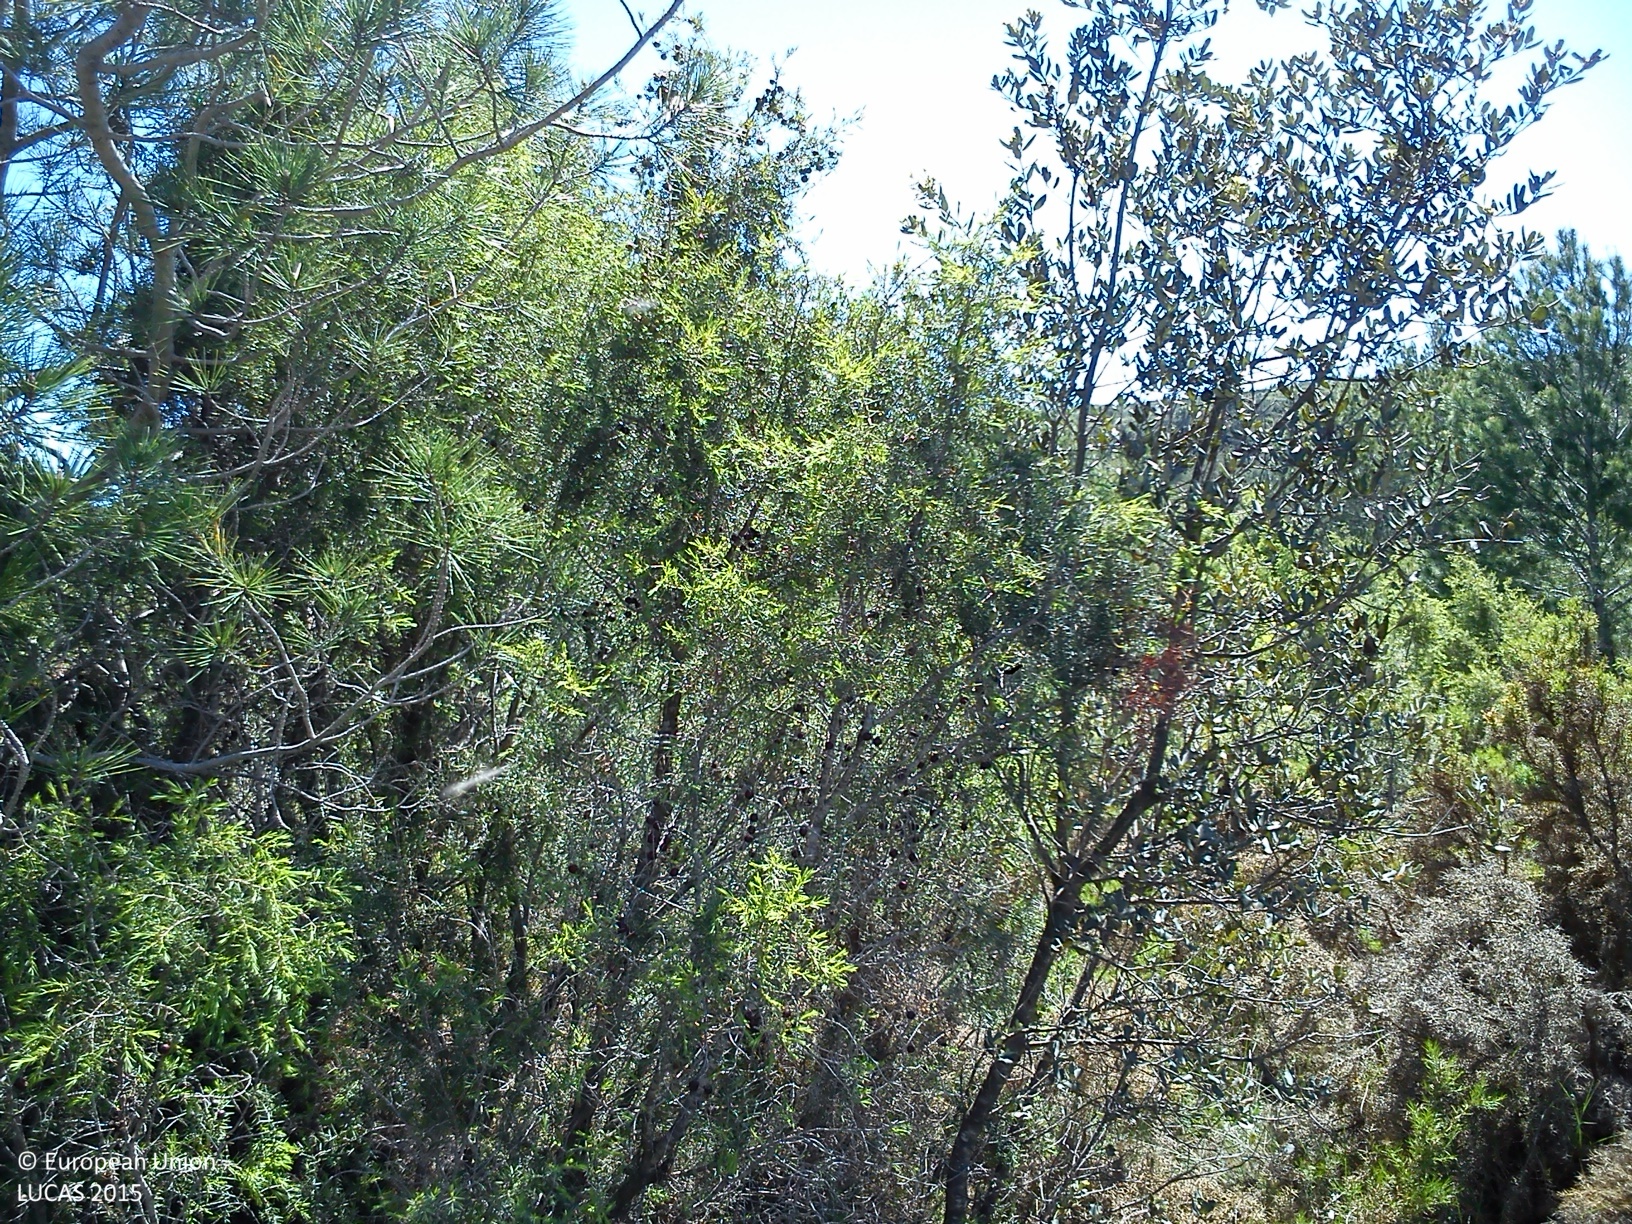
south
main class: Woodland
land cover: Pine dominated coniferous woodland
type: coniferous forest of the mediterranean region
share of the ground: > 75 %
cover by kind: shrubs 55 %, coniferous forest trees 35 %, herbaceous plants 10 %
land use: Semi-natural and natural areas not in use
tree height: > 5 m
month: May
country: ES
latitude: 39.5660
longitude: -0.9077
